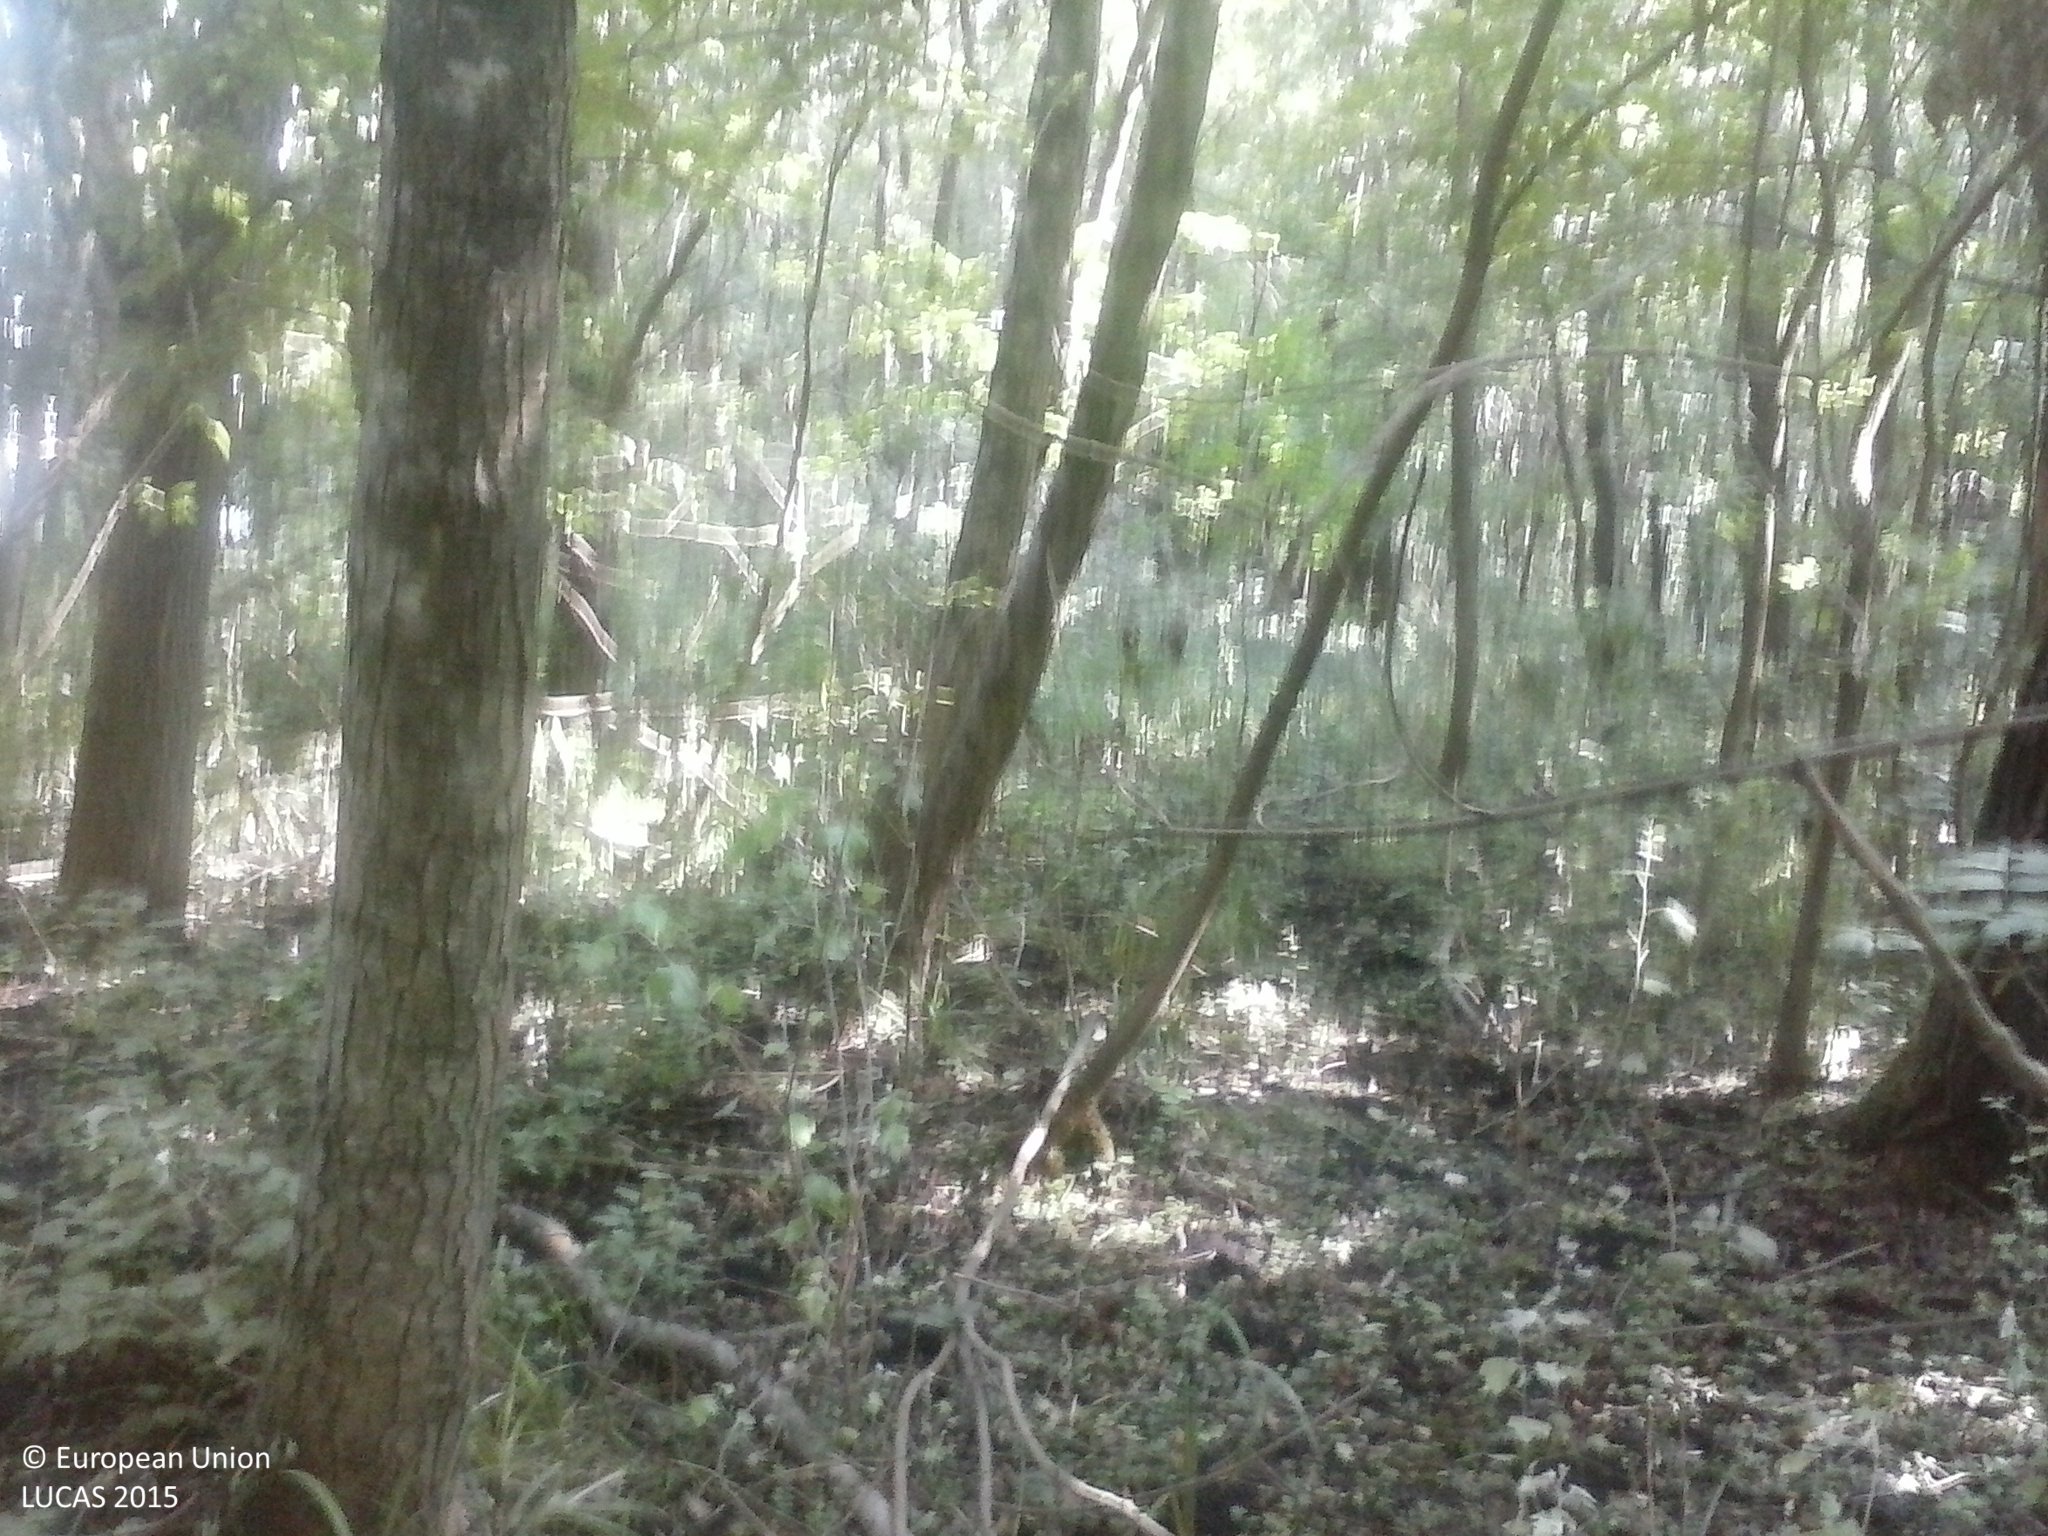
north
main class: Woodland
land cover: Broadleaved woodland
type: thermophilous deciduous forest
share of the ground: > 75 %
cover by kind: broadleaved forest trees 90 %, shrubs 5 %, herbaceous plants 5 %
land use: Forestry
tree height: > 5 m
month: August
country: HU
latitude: 45.8512
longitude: 17.7694
